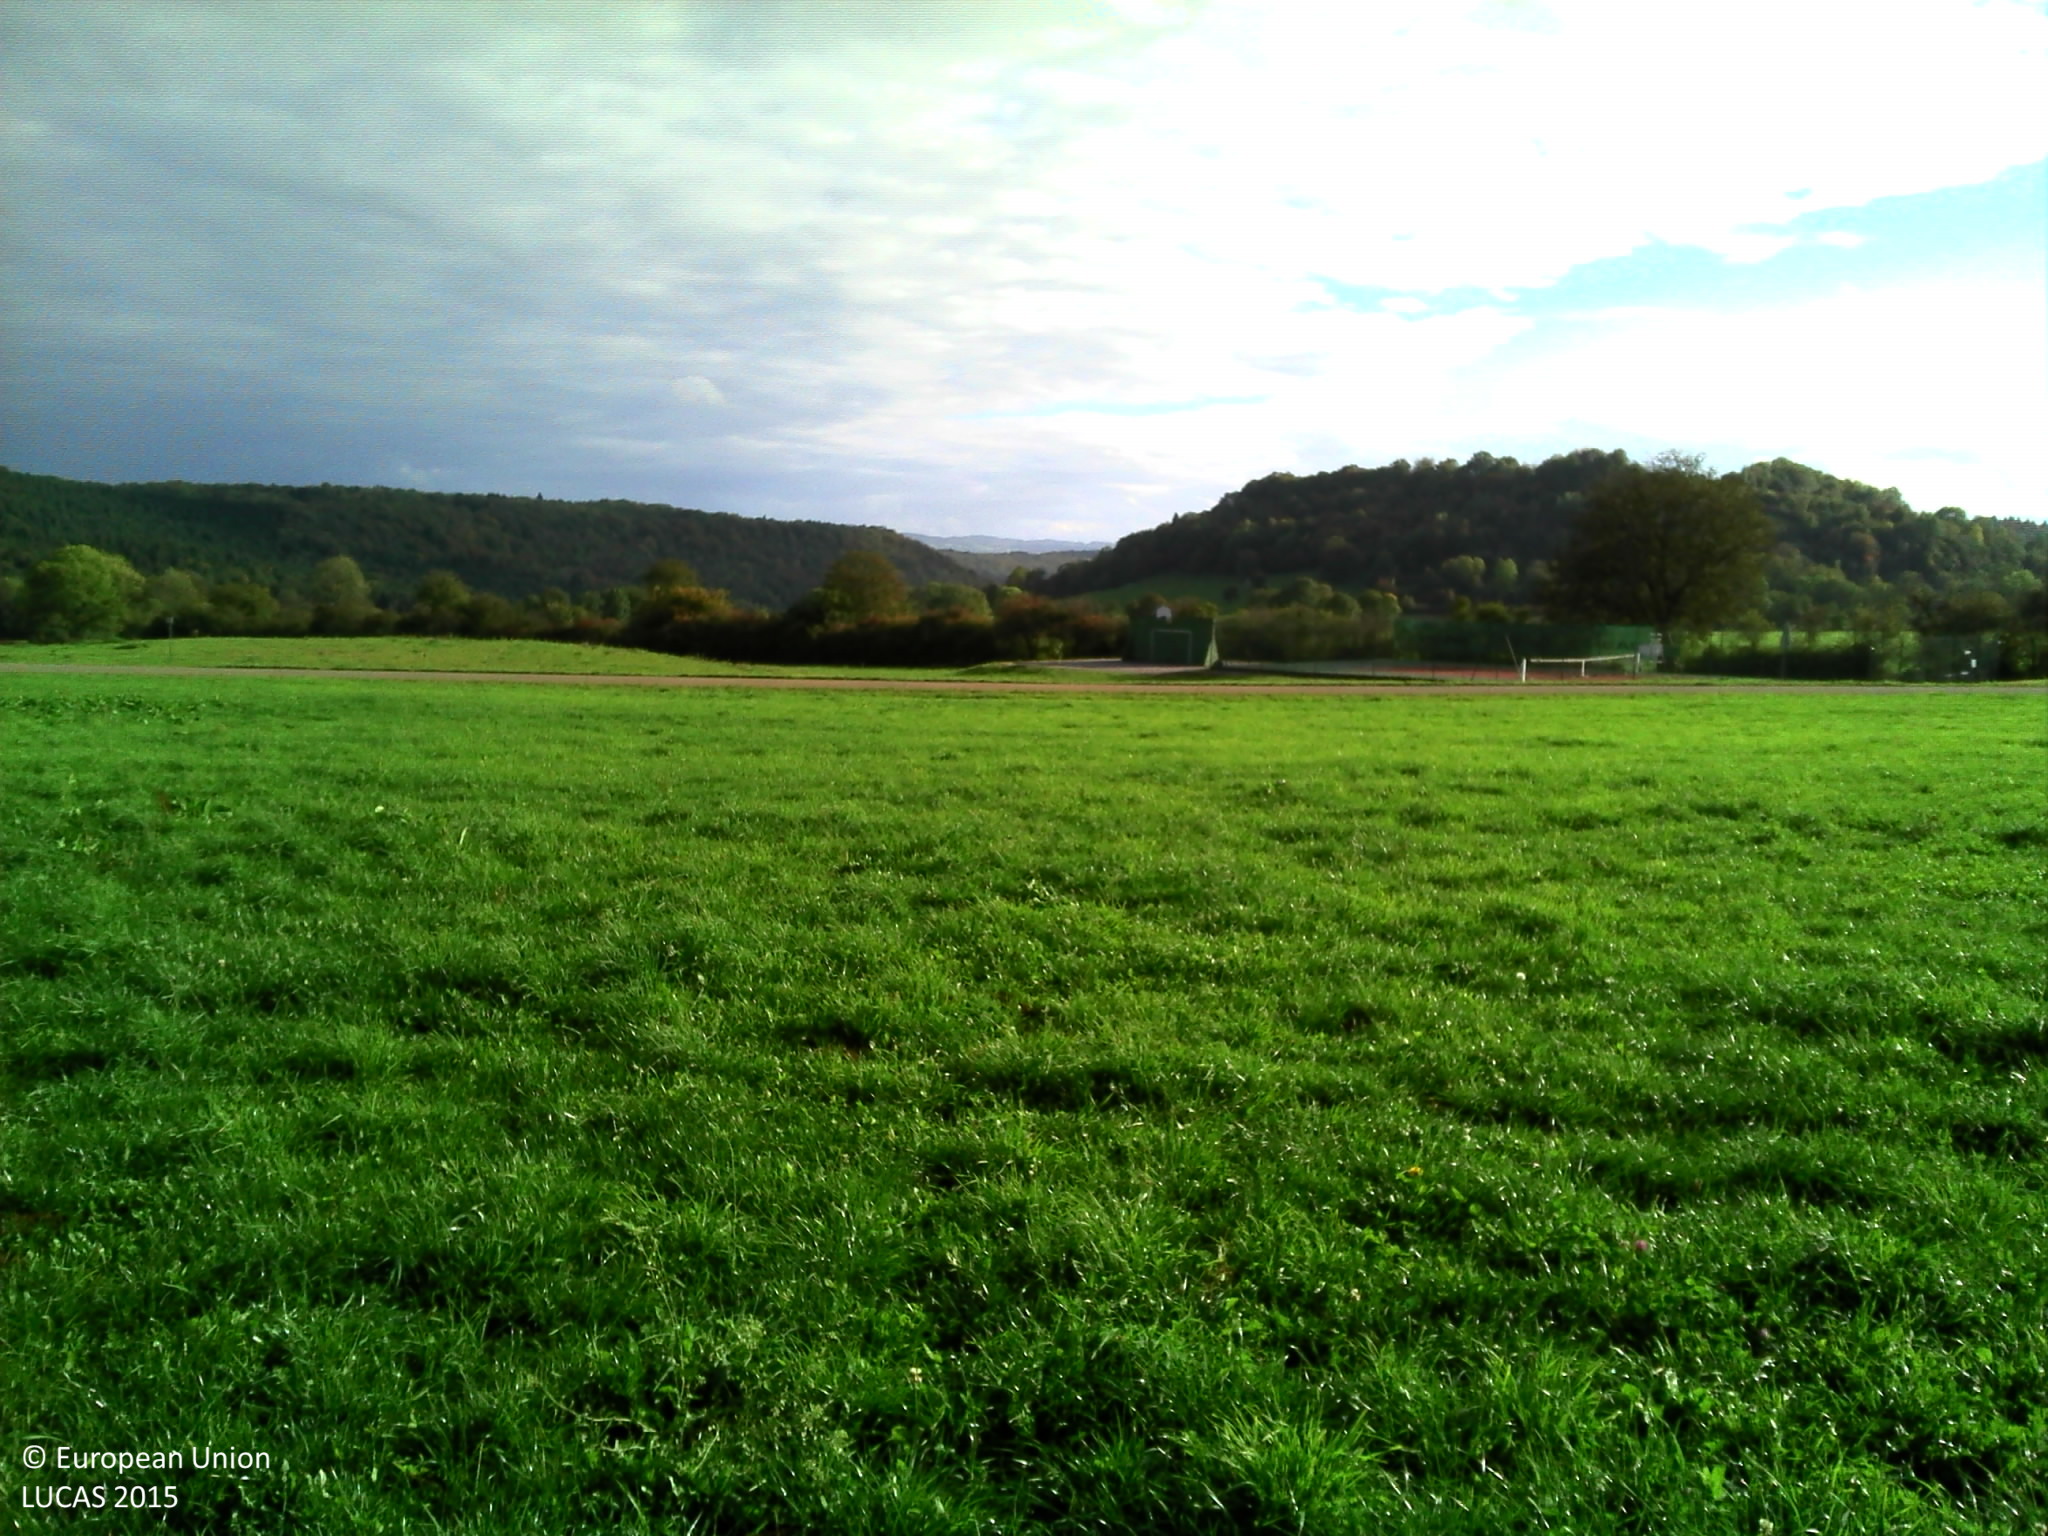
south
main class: Grassland
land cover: Grassland without tree/shrub cover
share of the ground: > 75 %
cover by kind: herbaceous plants 100 %
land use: Agriculture (excluding fallow land and kitchen gardens)
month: October
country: FR
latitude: 47.1251
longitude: 6.0342
